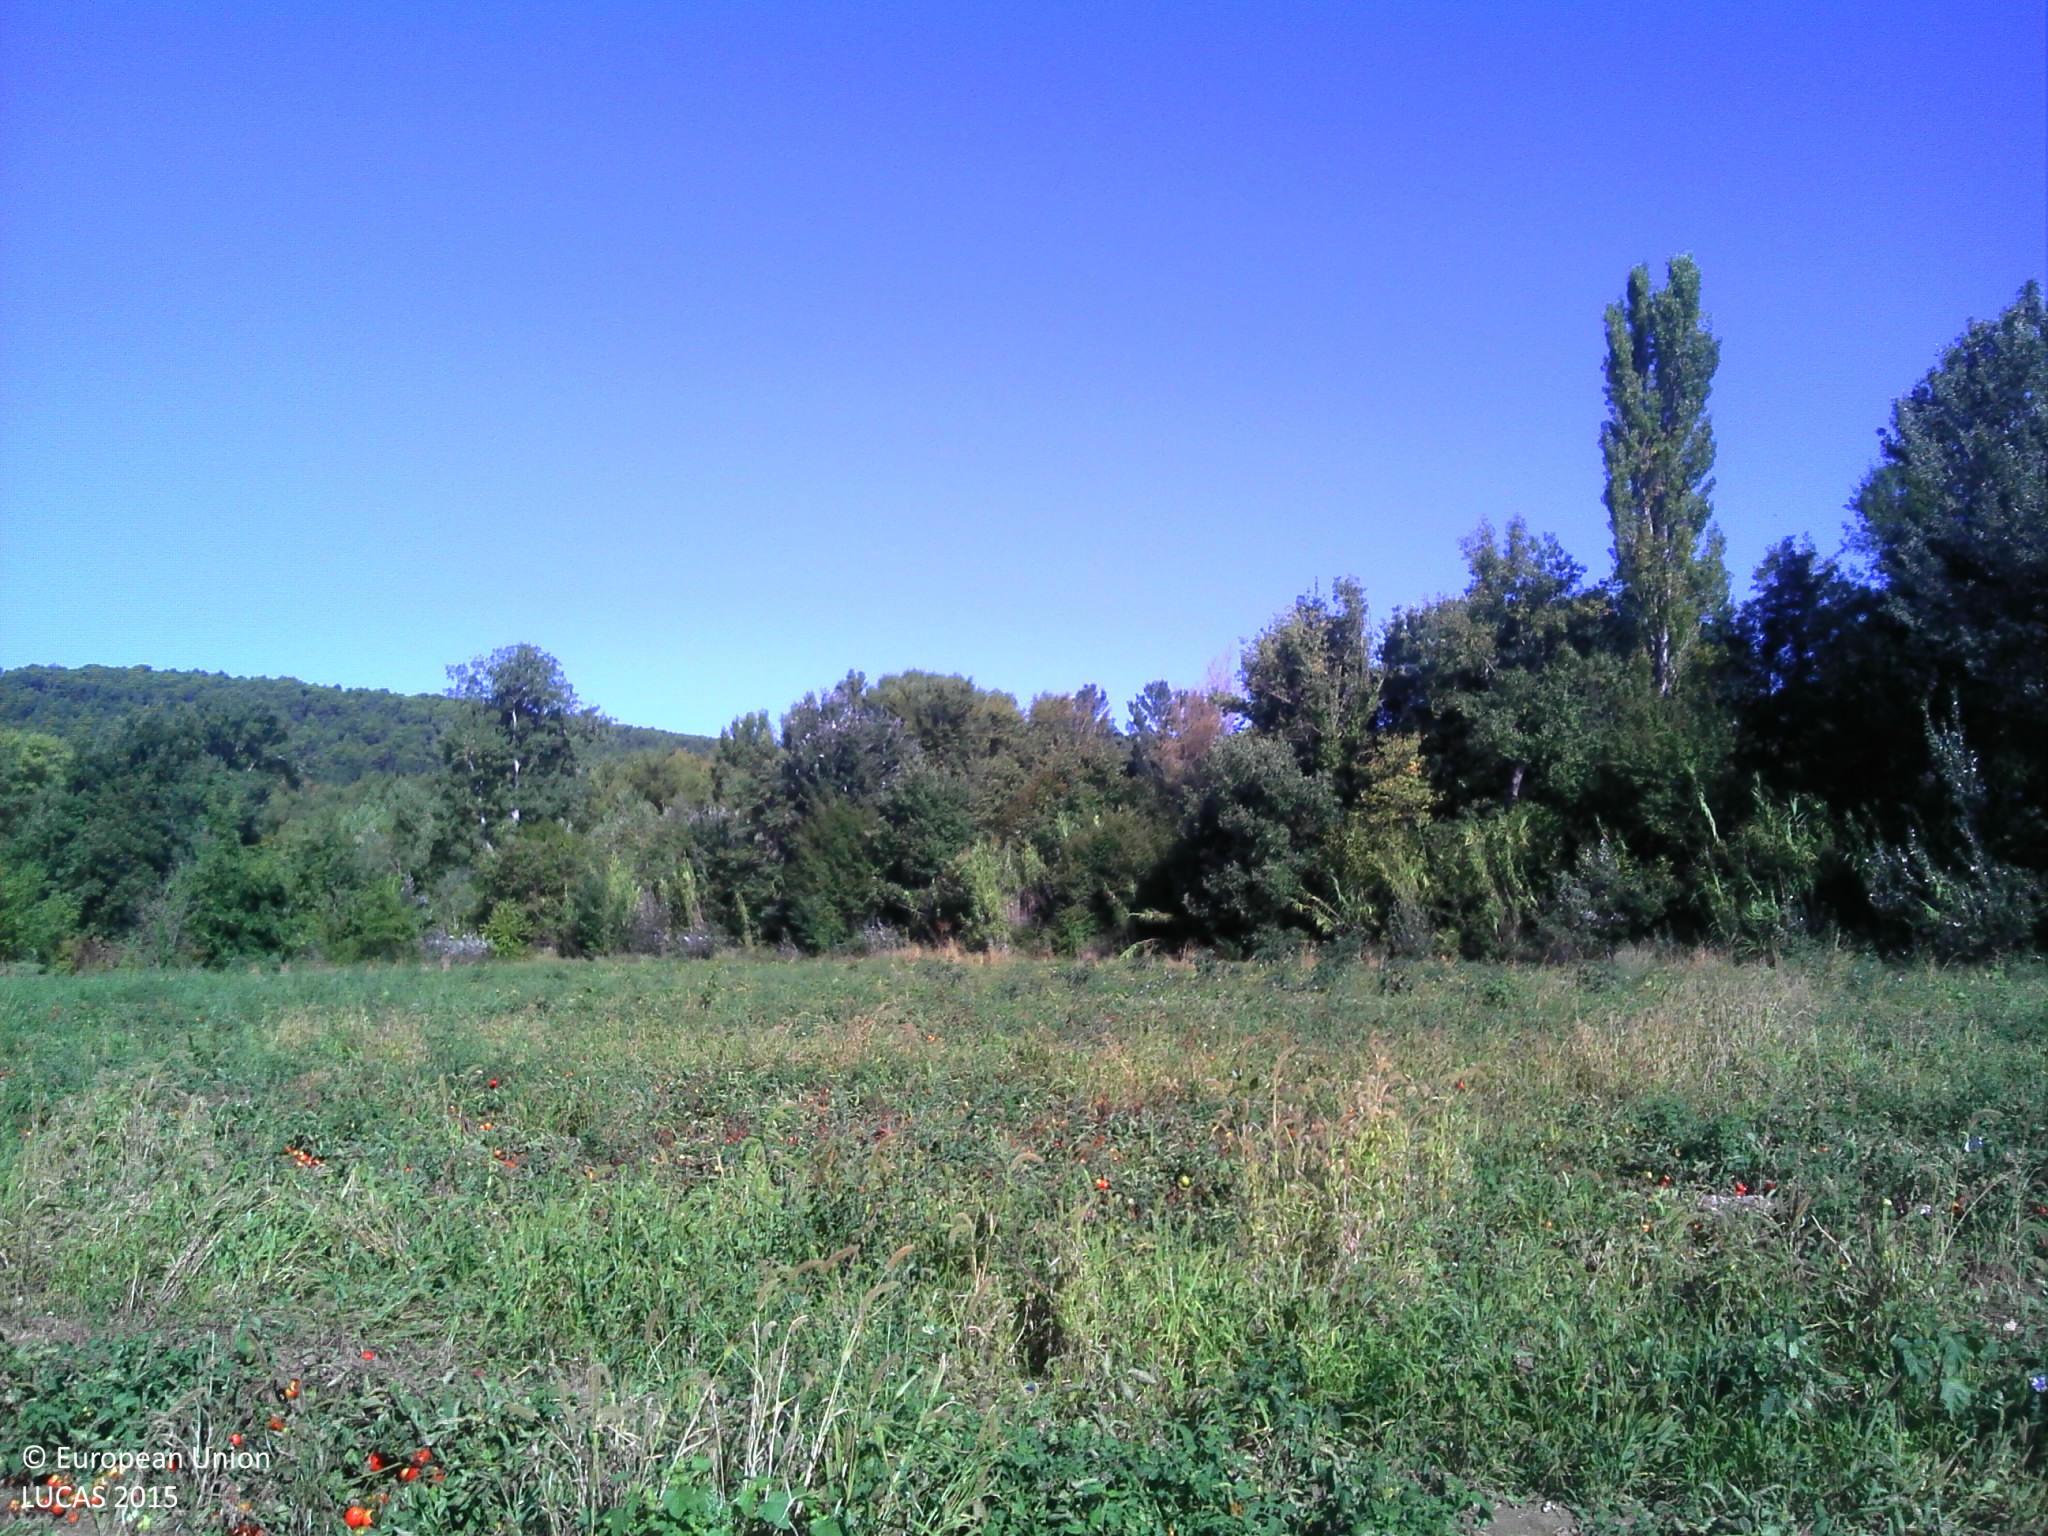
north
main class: Cropland
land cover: Tomatoes
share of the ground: > 75 %
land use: Agriculture (excluding fallow land and kitchen gardens)
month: September
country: FR
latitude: 44.2377
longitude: 5.1621
